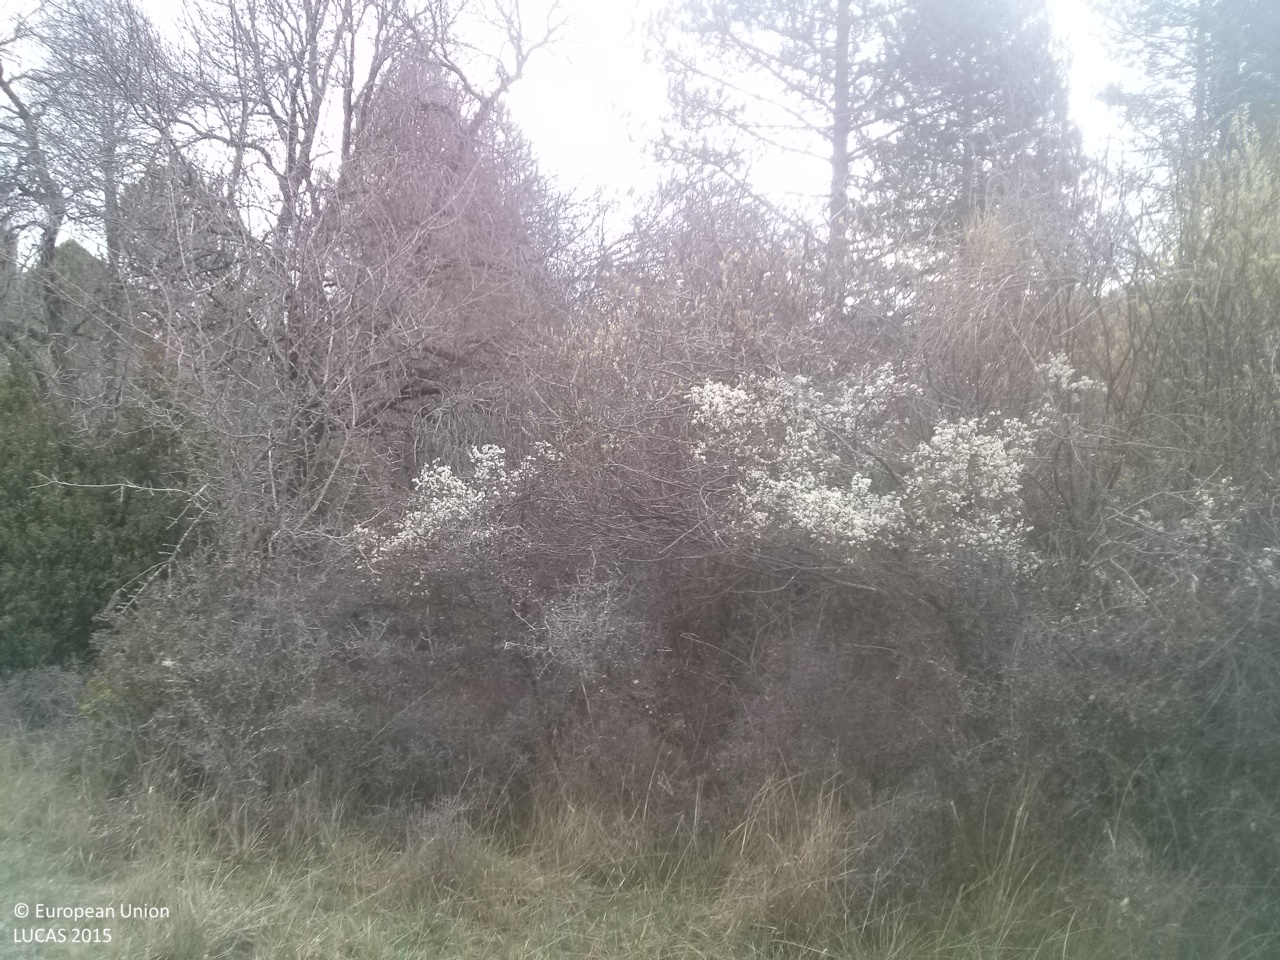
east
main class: Woodland
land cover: Broadleaved woodland
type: mesophytic deciduous forest
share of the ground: 25 - 50 %
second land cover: Grassland without tree/shrub cover
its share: 25 - 50 %
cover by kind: herbaceous plants 55 %, broadleaved forest trees 40 %, shrubs 5 %
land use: Forestry
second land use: Agriculture (excluding fallow land and kitchen gardens)
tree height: > 5 m
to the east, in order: Broadleaved woodland; Grassland without tree/shrub cover; Abandoned hedges; Ditches and canals; Abandoned hedges; Pine dominated mixed woodland; Pine dominated coniferous woodland; Grassland with sparse tree/shrub cover; Tracks; Pine dominated coniferous woodland; Abandoned hedges; Rivers and streams; Artificial constructions; Rivers and streams
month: April
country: ES
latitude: 40.2111
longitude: -1.9414
